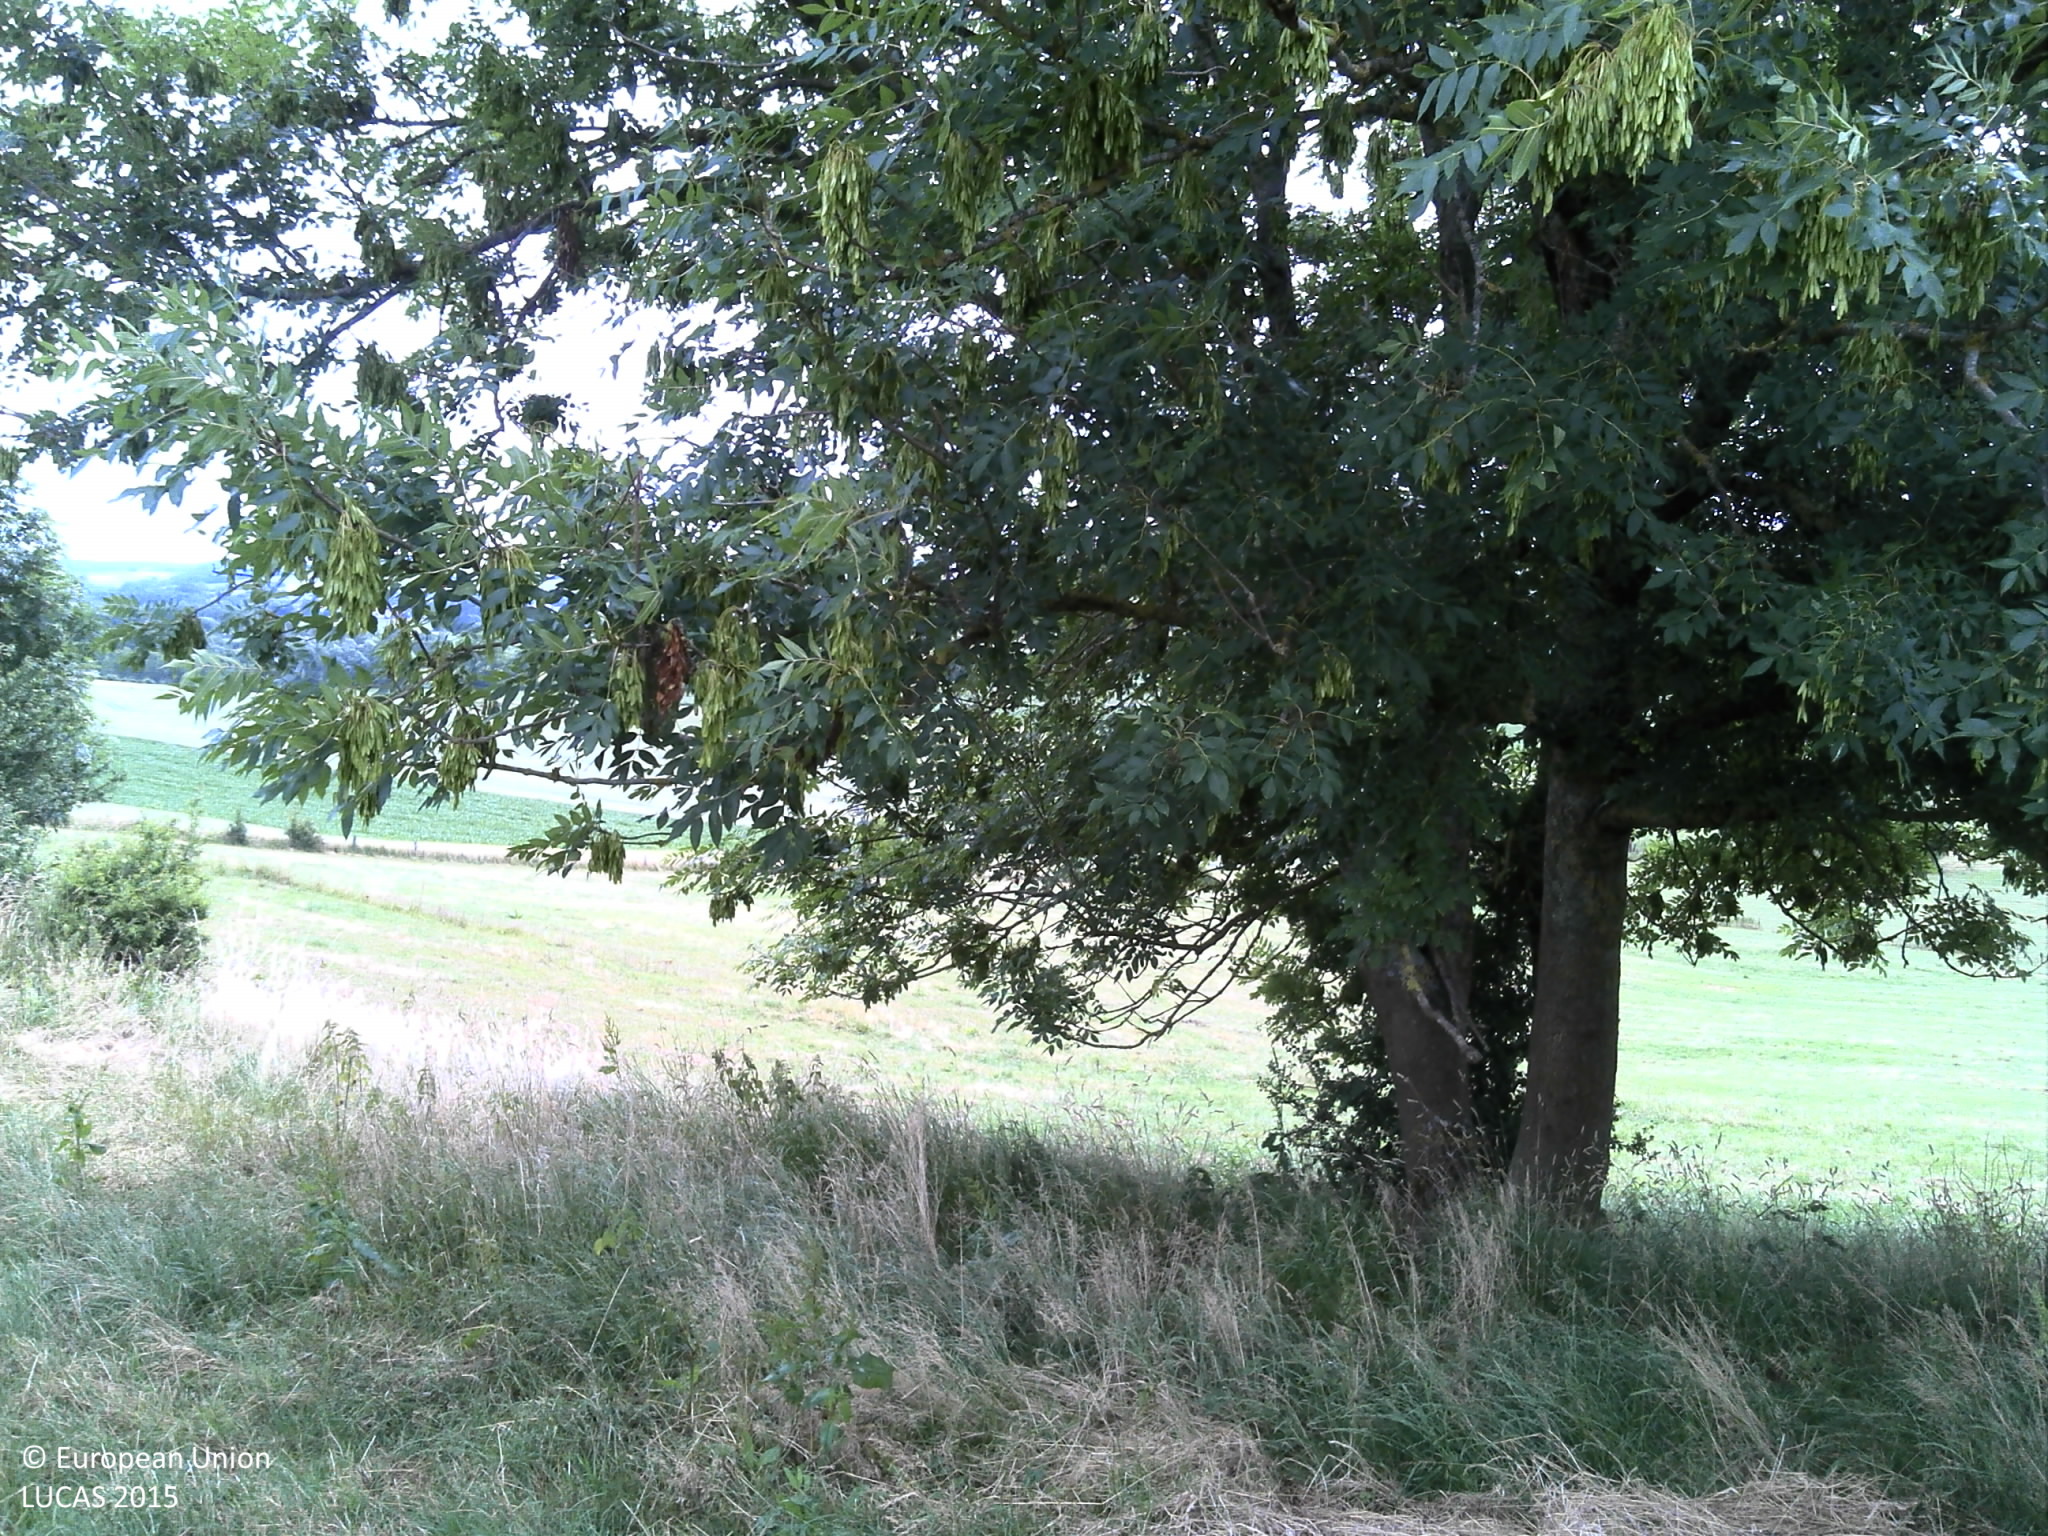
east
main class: Grassland
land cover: Grassland without tree/shrub cover
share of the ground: > 75 %
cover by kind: herbaceous plants 100 %
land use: Agriculture (excluding fallow land and kitchen gardens)
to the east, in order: Grassland without tree/shrub cover; Lines of trees; Grassland without tree/shrub cover; Fences; Common wheat; Maize; Common wheat
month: June
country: FR
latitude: 49.5799
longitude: 5.2264
